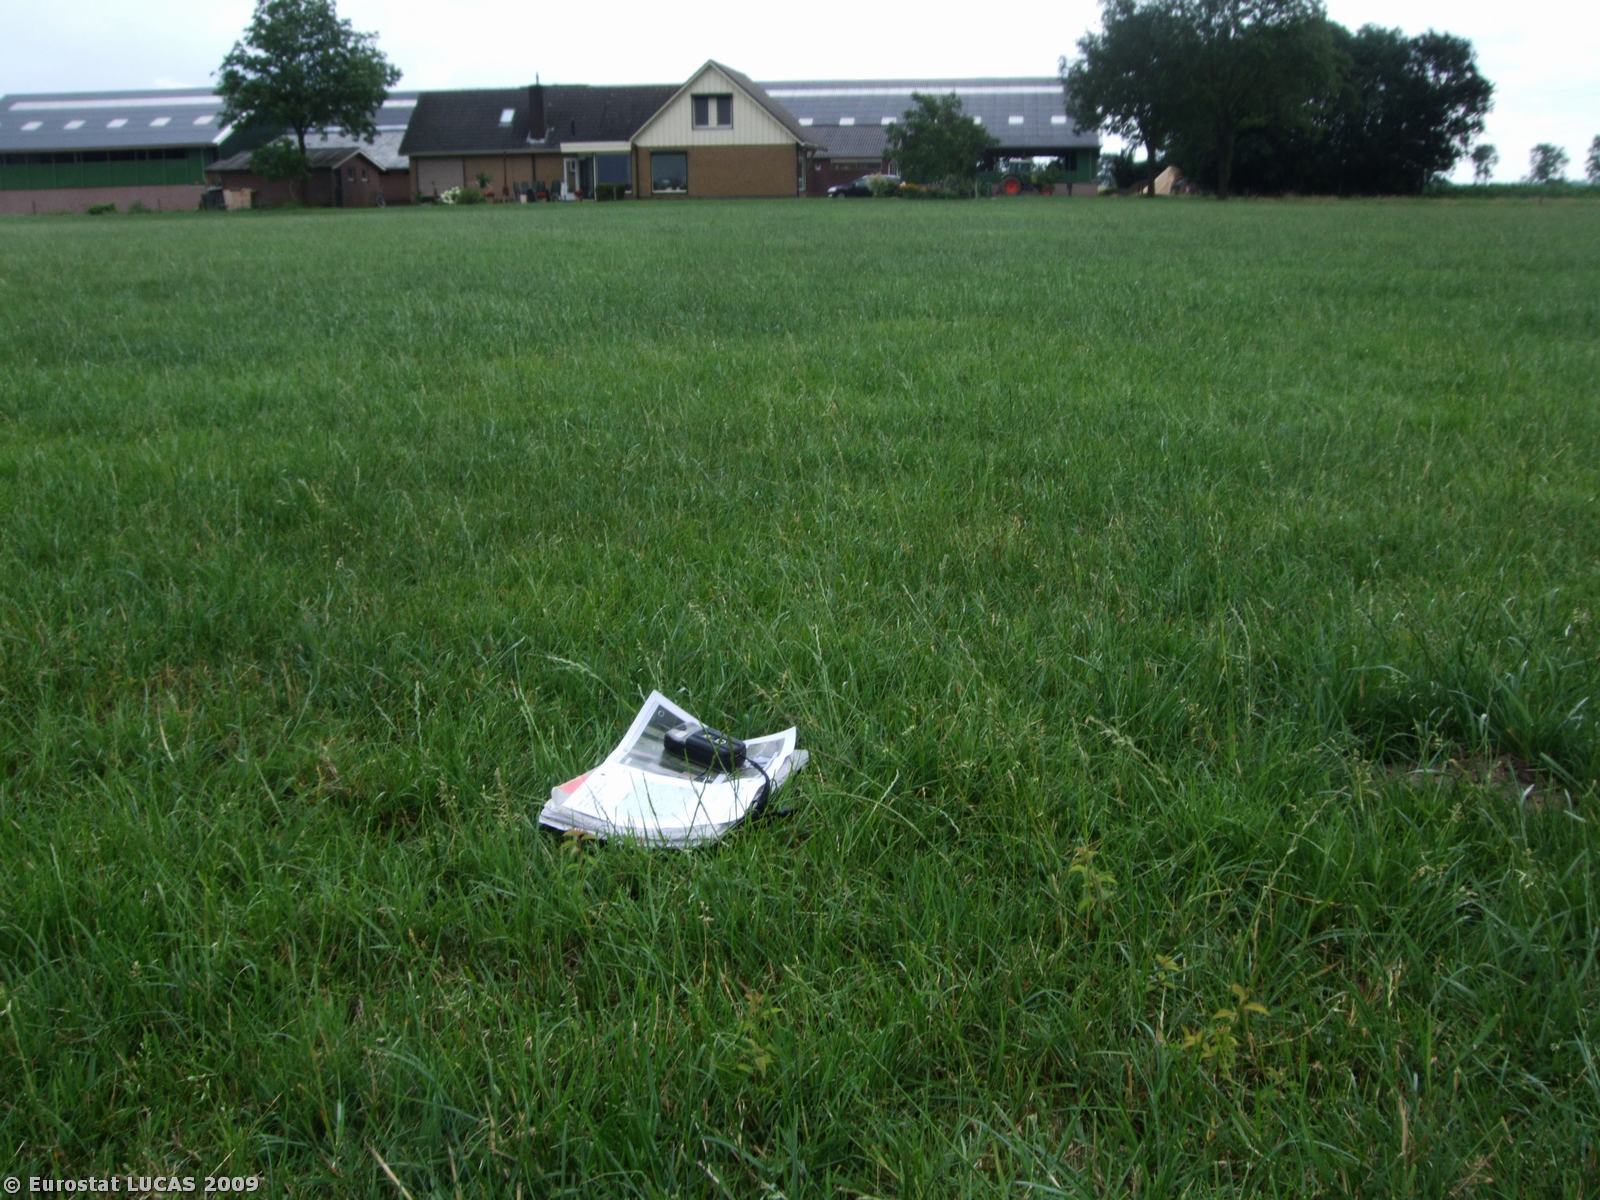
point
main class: Grassland
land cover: Grassland without tree/shrub cover
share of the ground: > 75 %
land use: Agriculture (excluding fallow land and kitchen gardens)
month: July
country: NL
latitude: 51.9719
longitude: 6.1126
